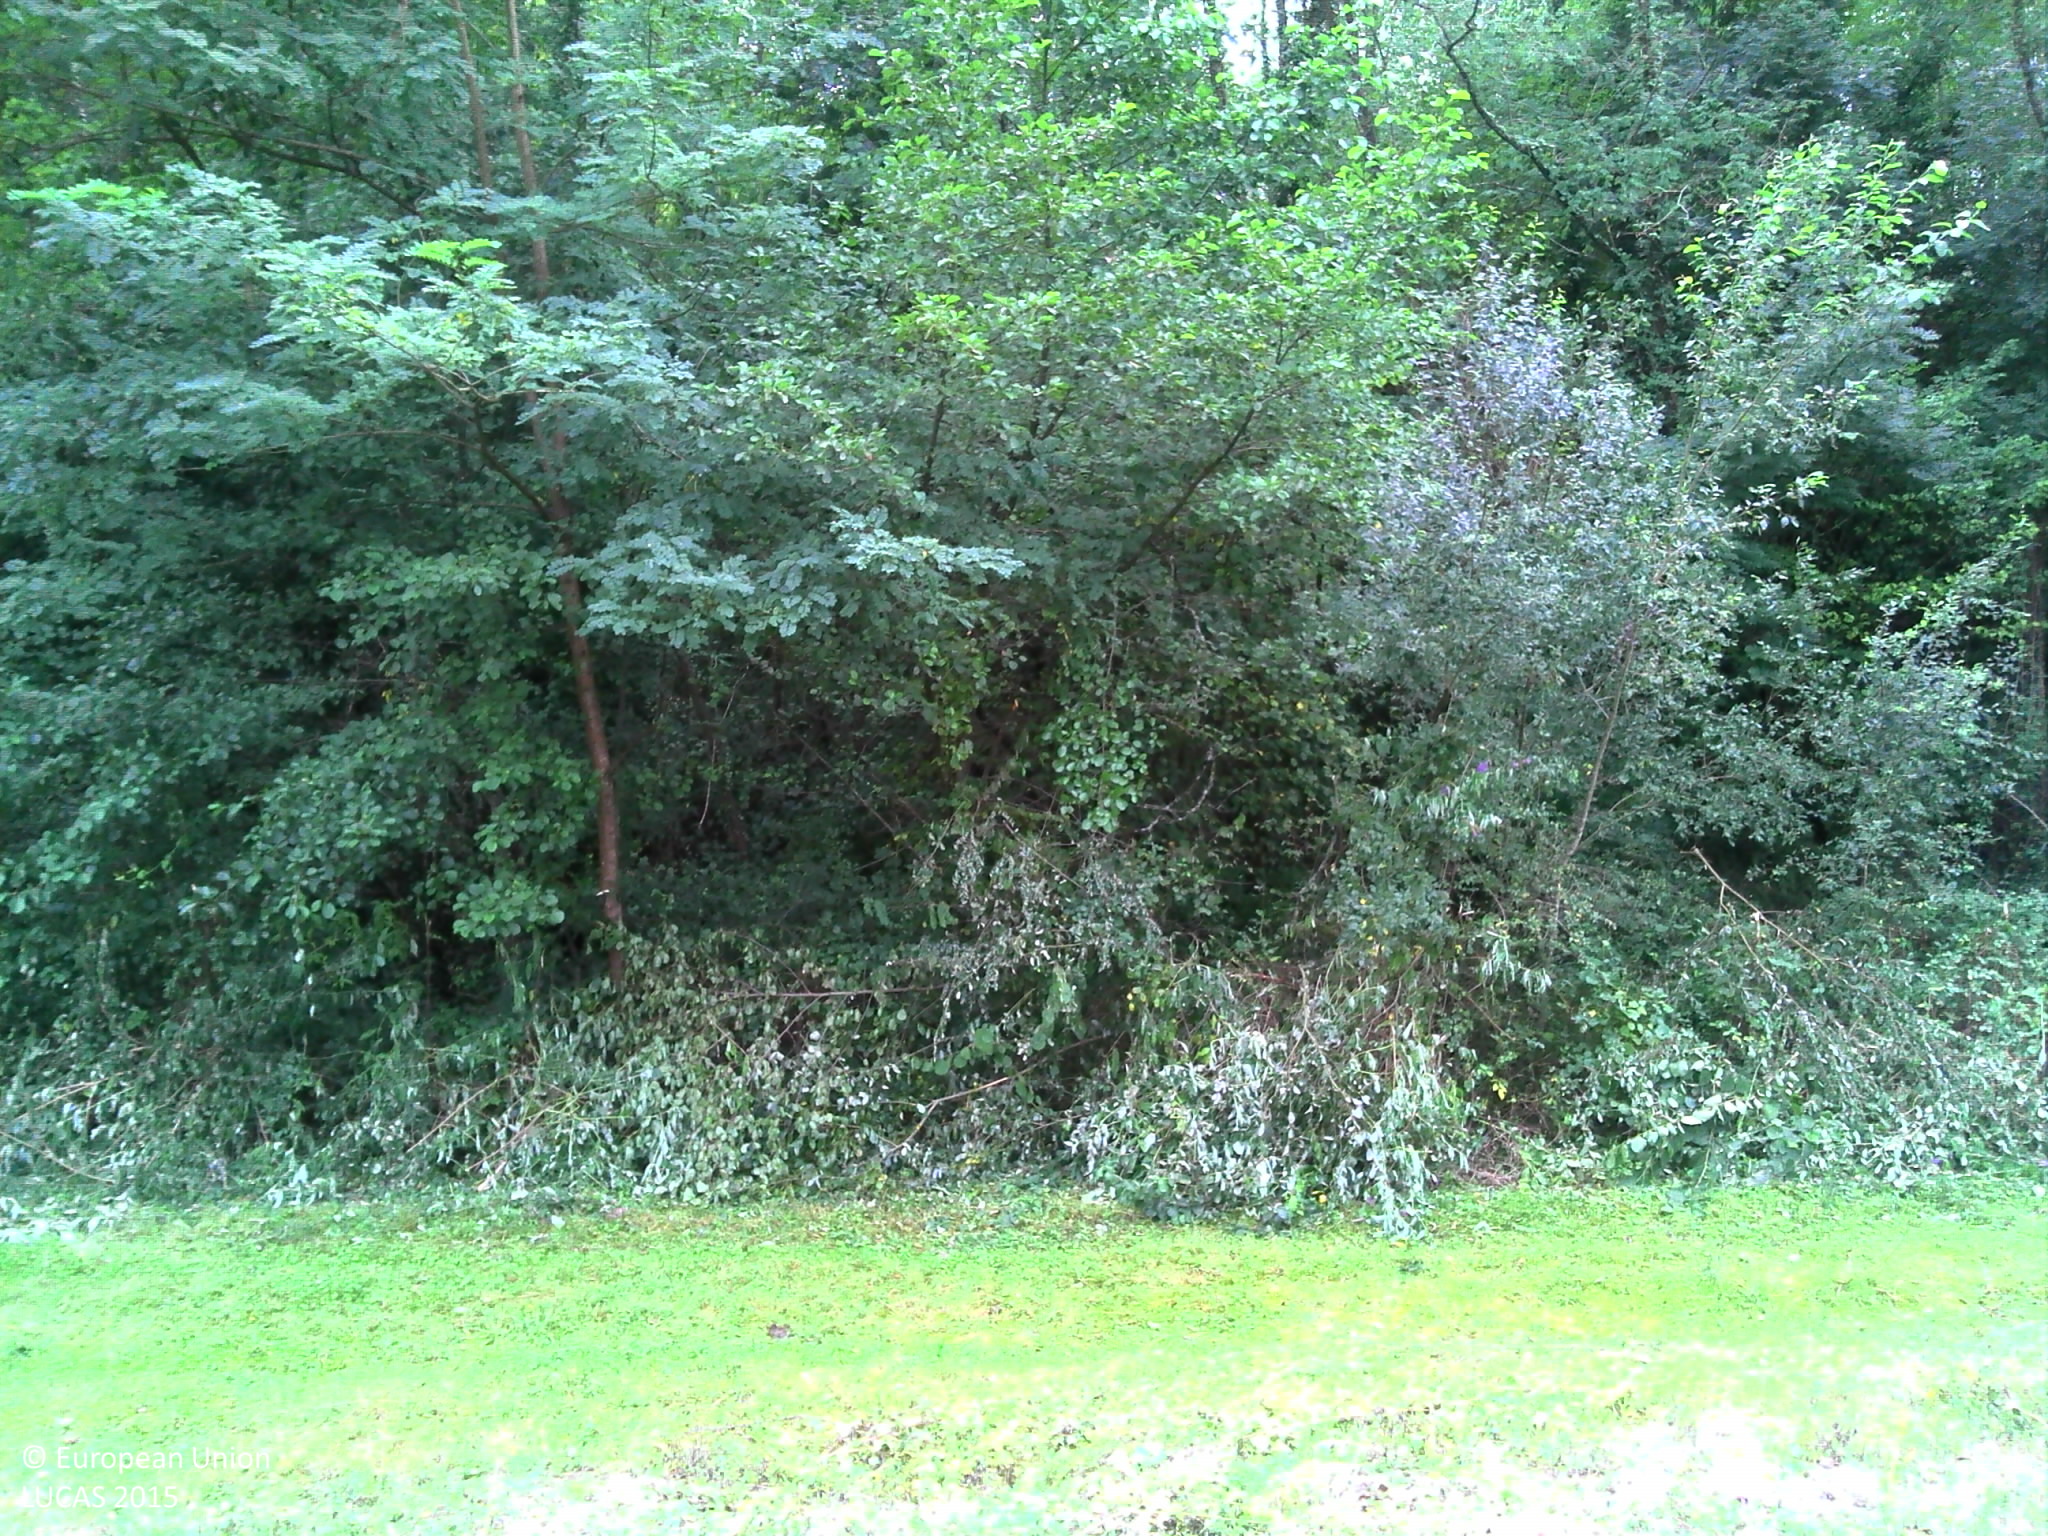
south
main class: Grassland
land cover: Grassland without tree/shrub cover
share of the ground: > 75 %
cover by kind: herbaceous plants 80 %, unconsolidated bare surface 15 %, shrubs 5 %
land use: Agriculture (excluding fallow land and kitchen gardens)
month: September
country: FR
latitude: 43.1746
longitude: -0.8972
